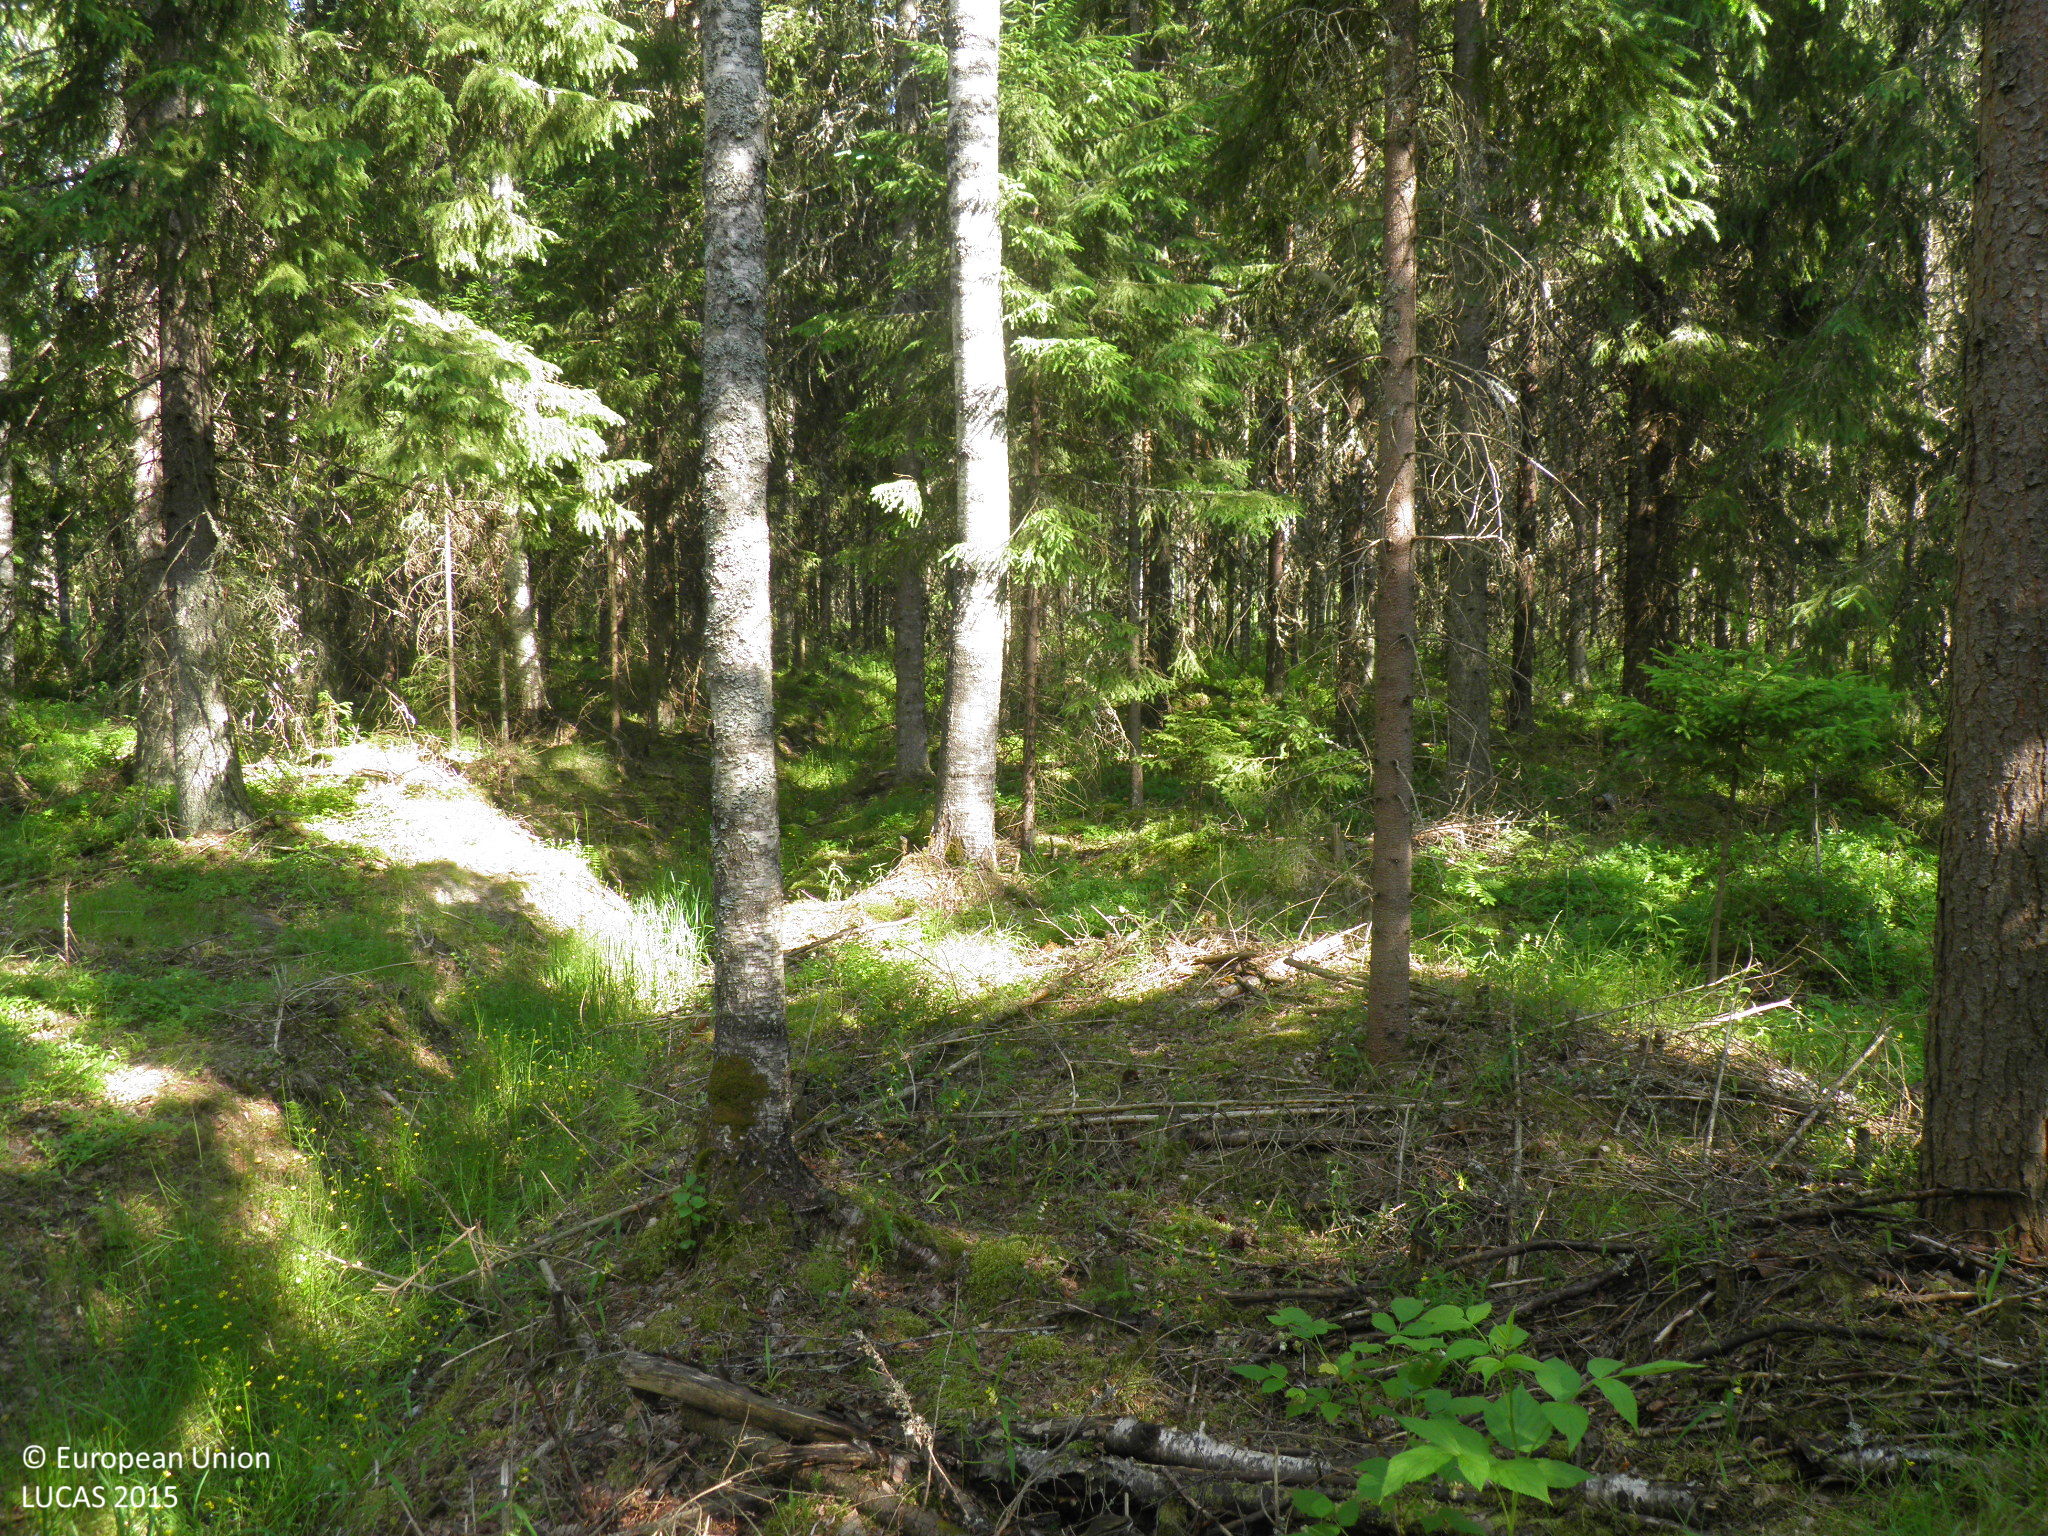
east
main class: Woodland
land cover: Spruce dominated mixed woodland
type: hemiboreal forest and nemoral coniferous forest and mixed broadleaved-coniferous forest
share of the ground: 50 - 75 %
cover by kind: coniferous forest trees 40 %, broadleaved forest trees 30 %, shrubs 10 %, herbaceous plants 10 %, lichens and mosses 10 %
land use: Forestry
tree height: > 5 m
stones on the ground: < 10 %
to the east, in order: Spruce dominated mixed woodland; Ditches and canals; Spruce dominated mixed woodland; Ditches and canals; Spruce dominated coniferous woodland; Ditches and canals; Spruce dominated coniferous woodland; Tracks; Spruce dominated coniferous woodland; Ditches and canals; Spruce dominated mixed woodland; Ditches and canals; Tracks; Ditches and canals; Spruce dominated coniferous woodland
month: July
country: FI
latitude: 60.6250
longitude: 22.9239
